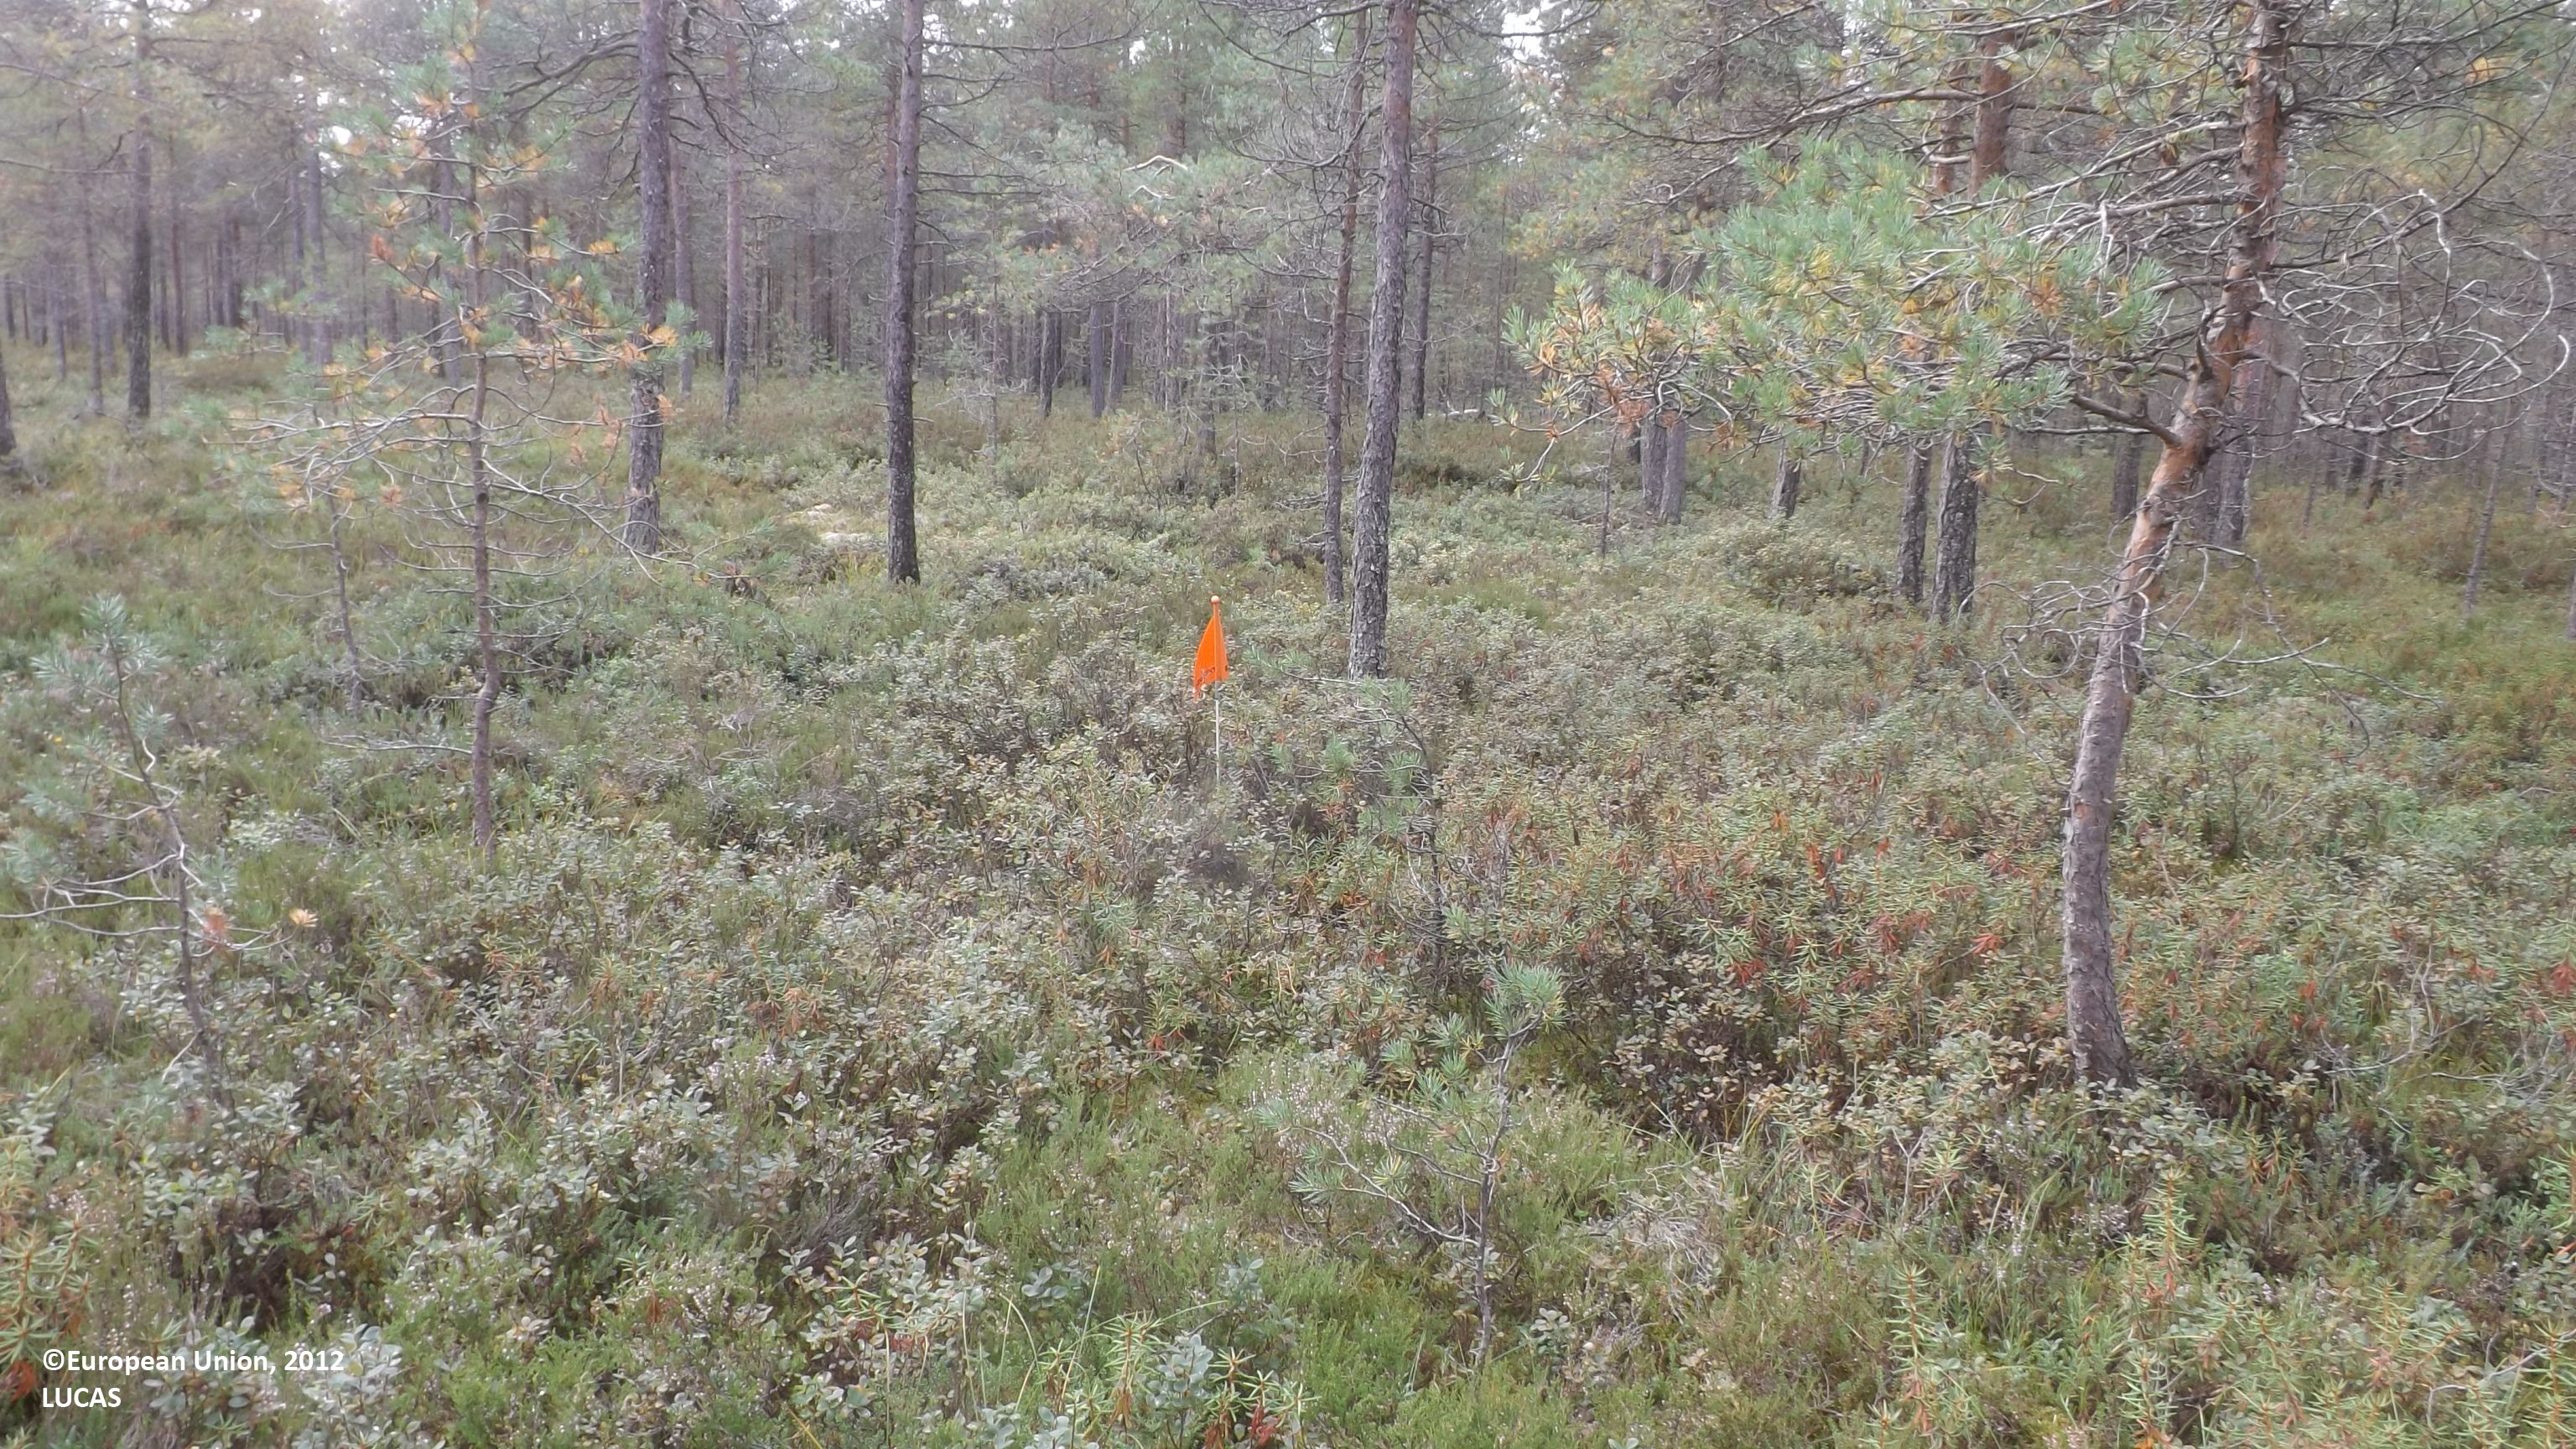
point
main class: Woodland
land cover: Pine dominated coniferous woodland
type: boreal forest
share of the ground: 25 - 50 %
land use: Forestry
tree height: > 5 m
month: August
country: FI
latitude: 63.9005
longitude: 23.6081
